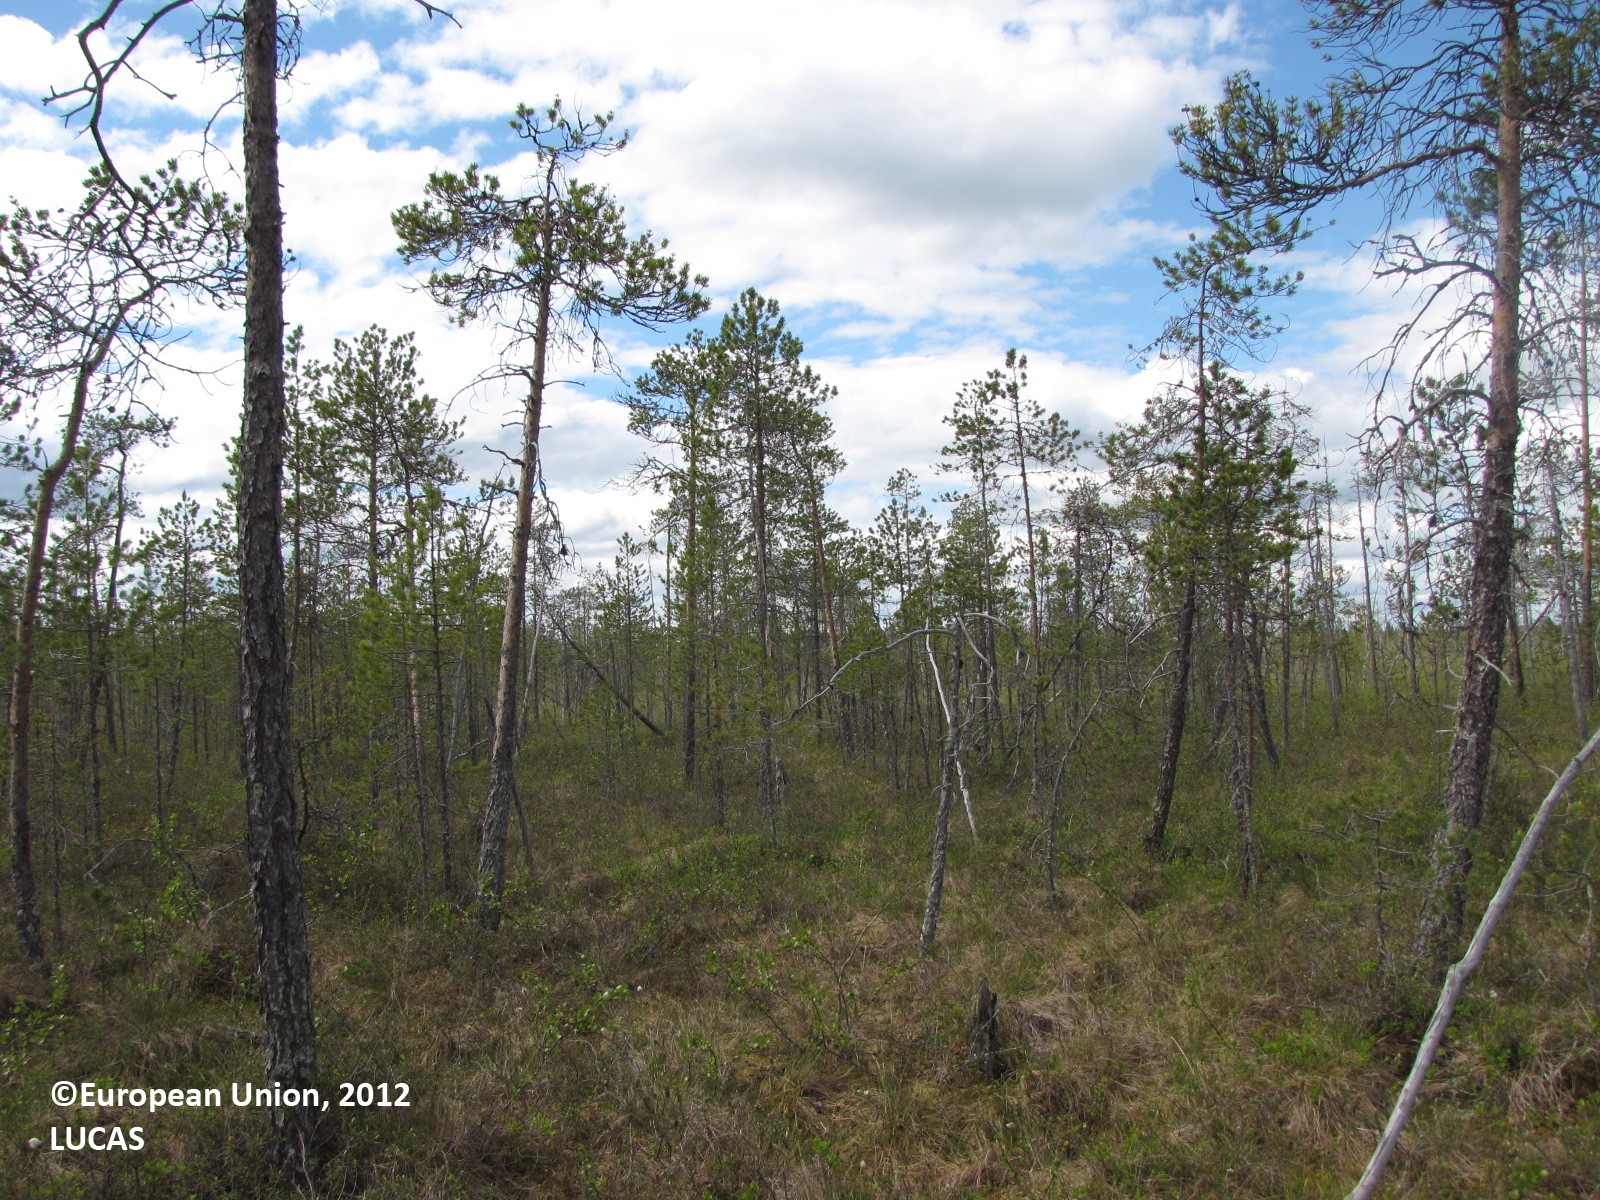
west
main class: Woodland
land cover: Pine dominated coniferous woodland
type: boreal forest
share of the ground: 10 - 25 %
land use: Forestry
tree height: > 5 m
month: June
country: FI
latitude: 66.0991
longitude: 25.2151
